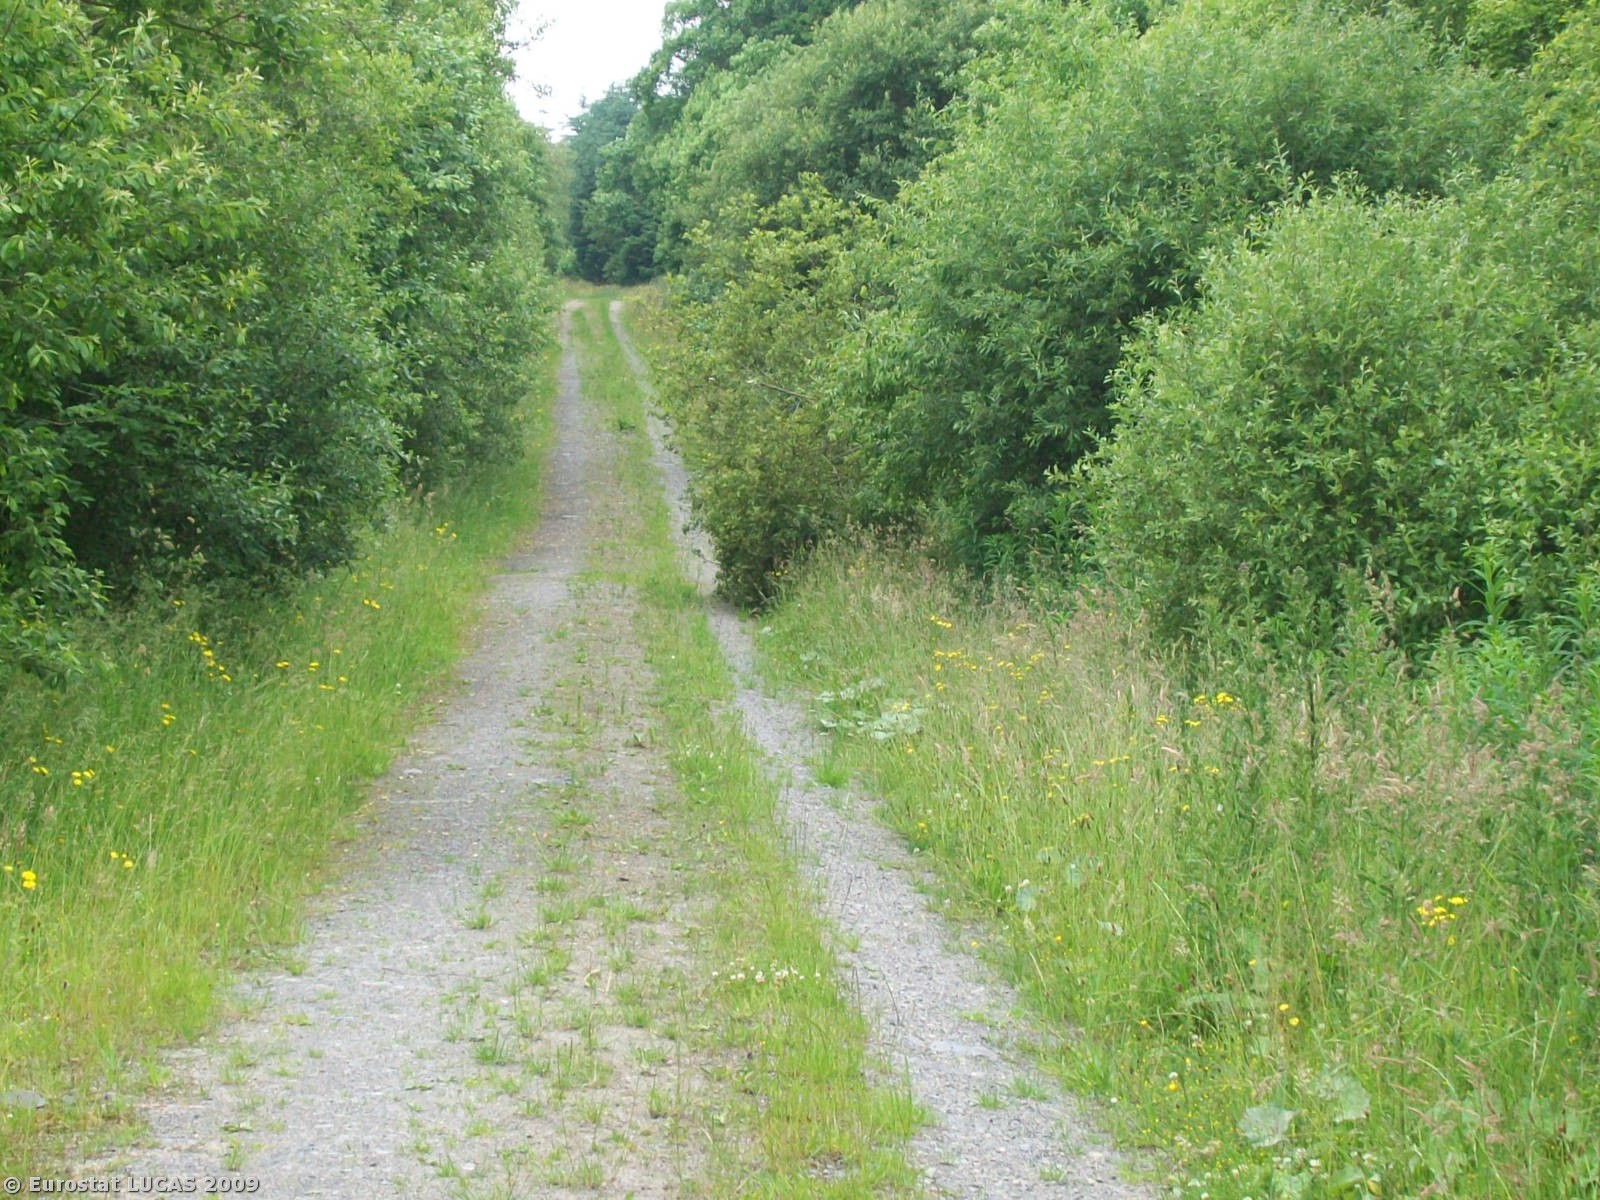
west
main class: Woodland
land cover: Coniferous woodland
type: plantations and self-sown exotic forest
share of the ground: > 75 %
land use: Forestry
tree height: > 5 m
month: June
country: GB
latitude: 53.0435
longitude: -3.4930
